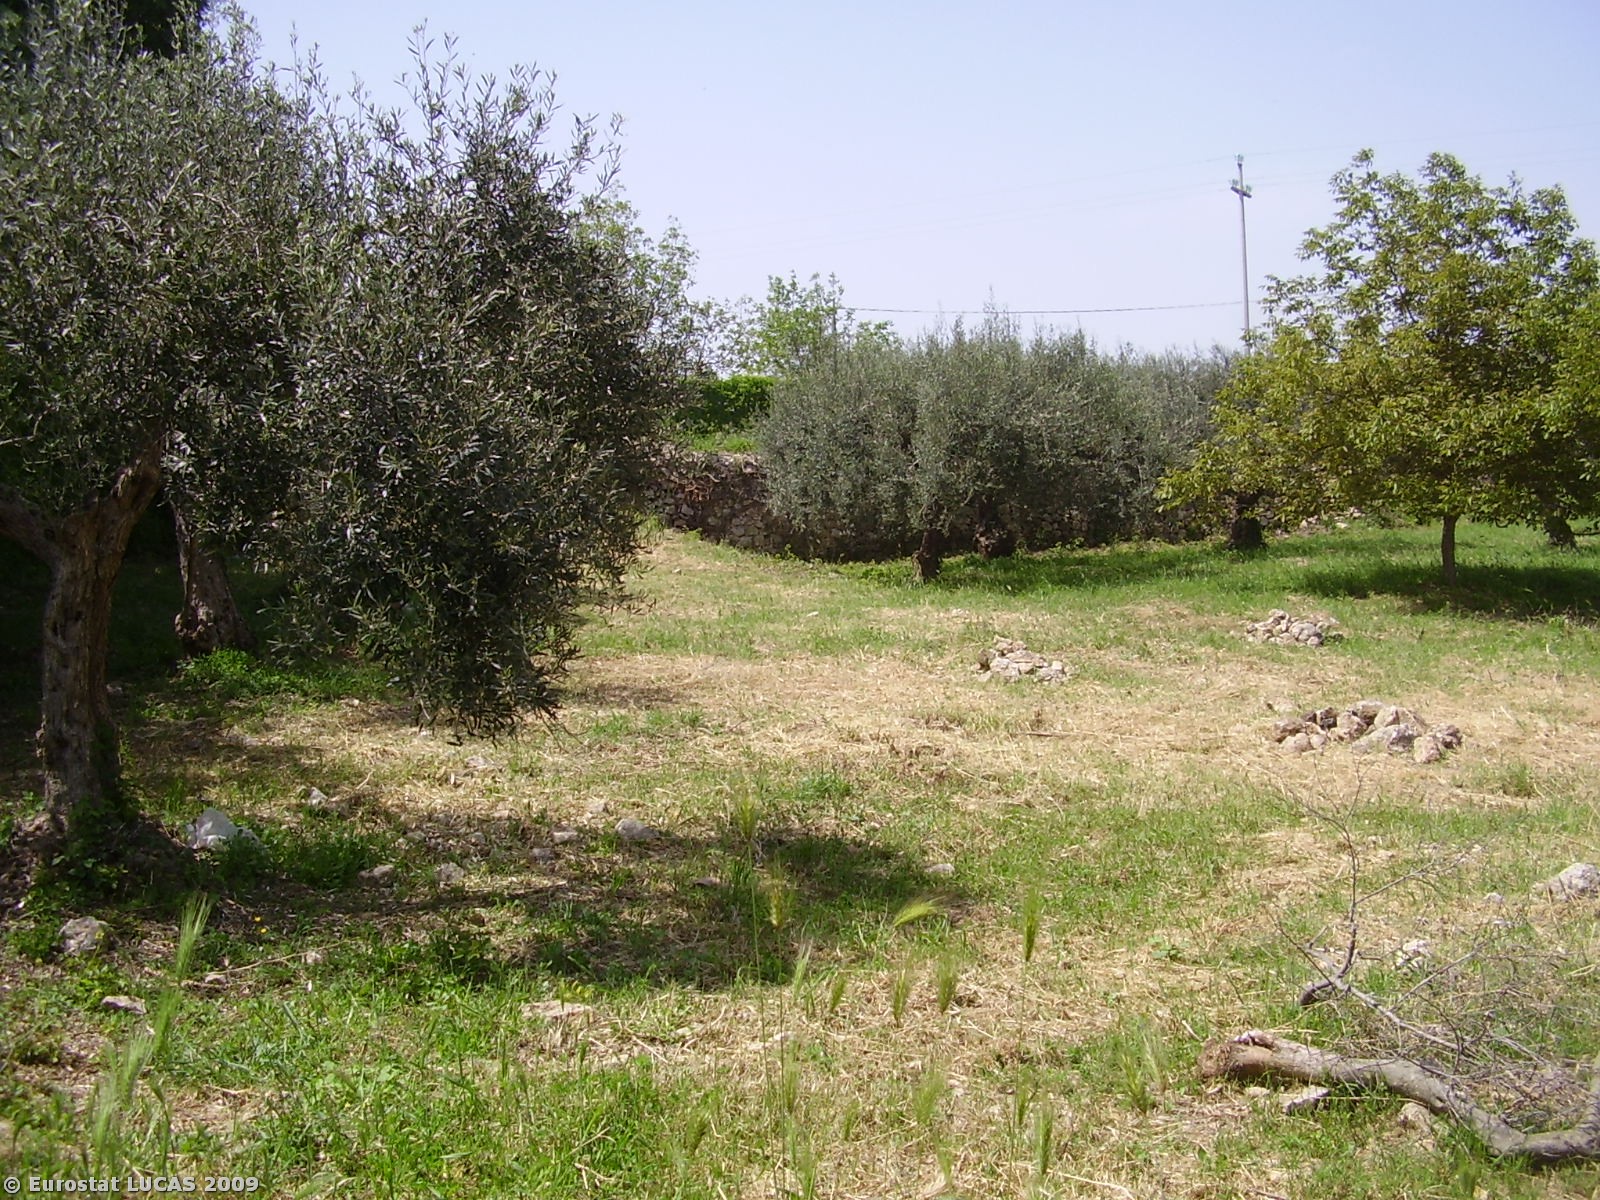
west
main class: Shrubland
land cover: Shrubland with sparse tree cover
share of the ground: 50 - 75 %
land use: Agriculture (excluding fallow land and kitchen gardens)
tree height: < 5 m
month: May
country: IT
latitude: 37.1276
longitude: 14.9485
